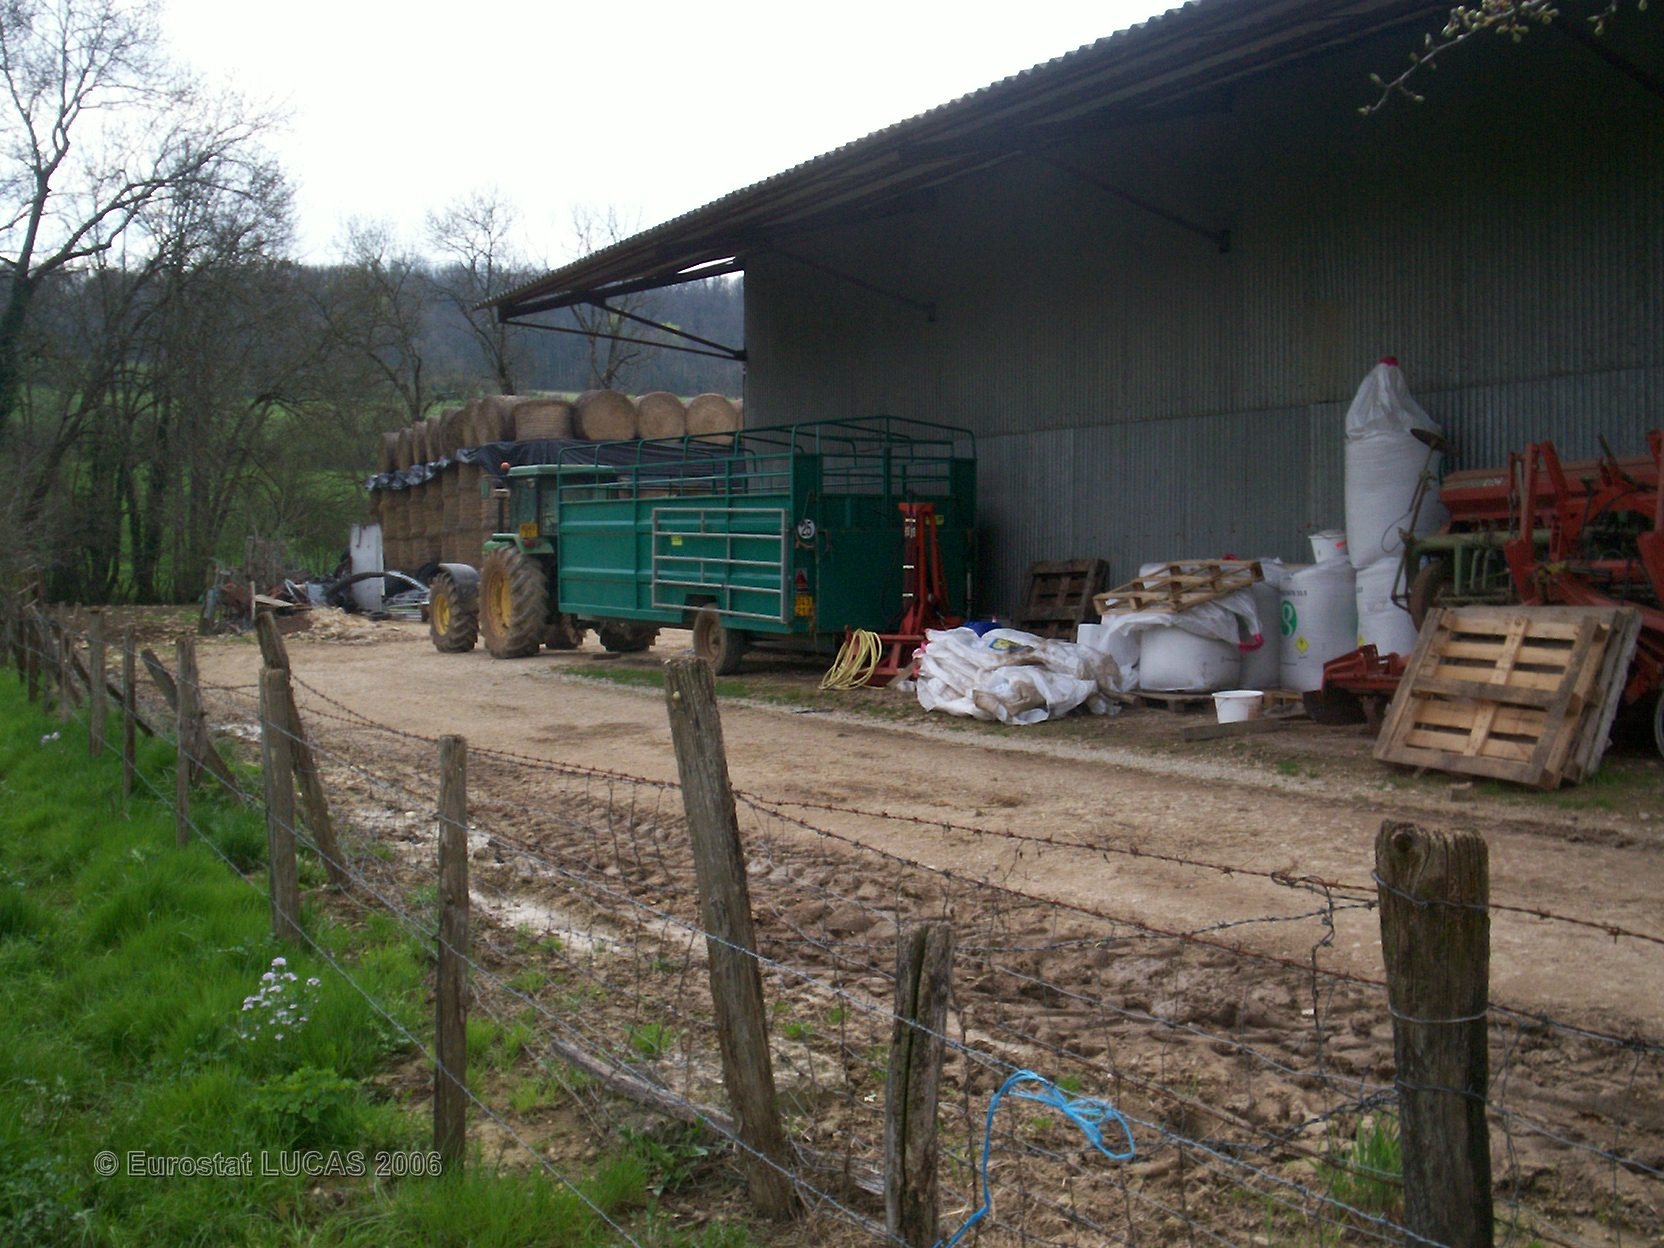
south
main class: Grassland
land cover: Grassland without tree/shrub cover
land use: Agriculture (excluding fallow land and kitchen gardens)
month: April
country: FR
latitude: 47.5484
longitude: 4.5646
